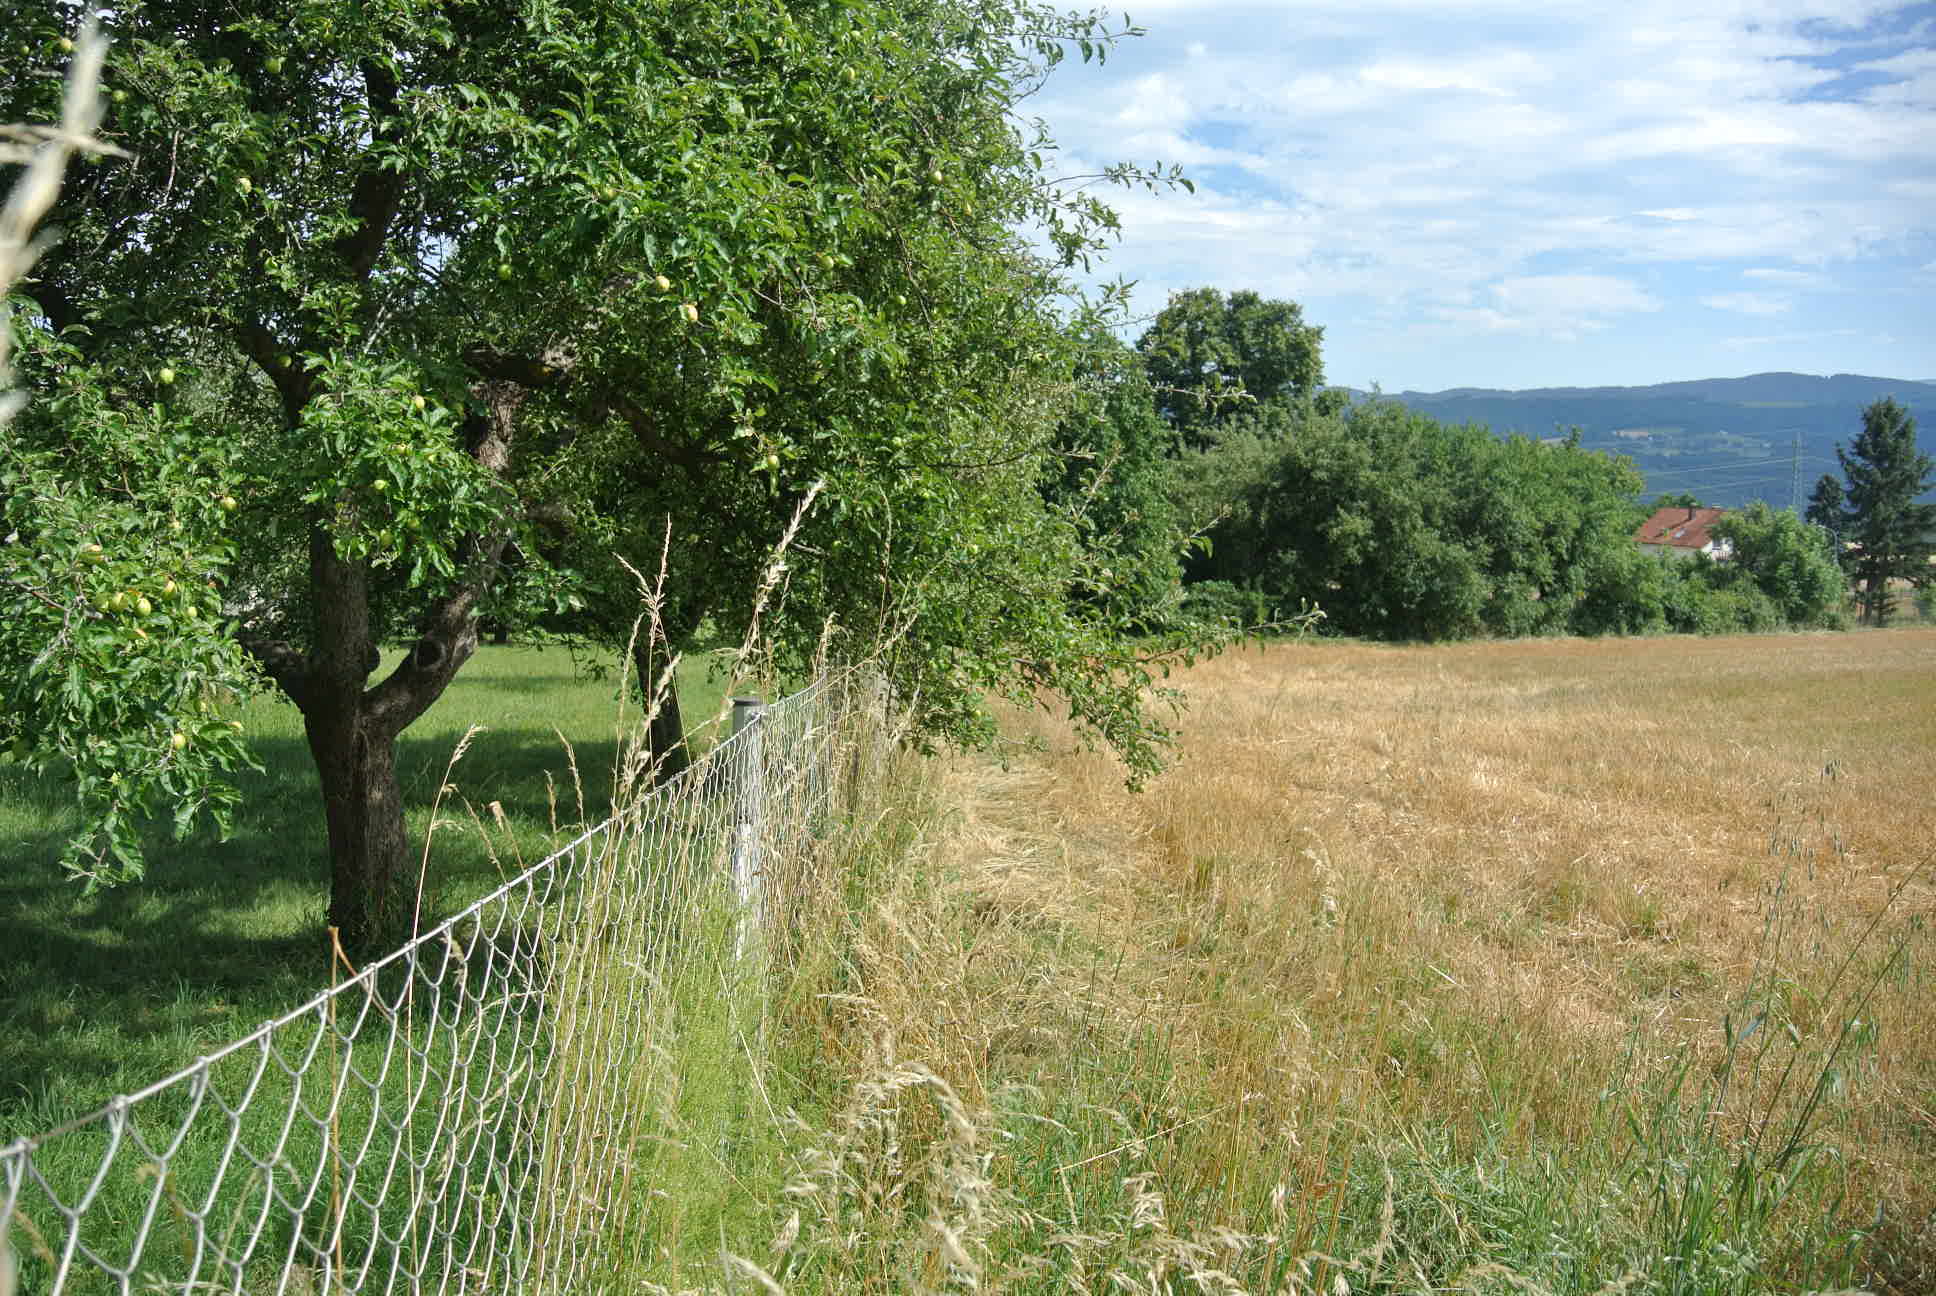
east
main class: Cropland
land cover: Apple fruit
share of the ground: > 75 %
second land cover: Grassland without tree/shrub cover
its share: > 75 %
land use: Kitchen garden
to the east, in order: Apple fruit; Grassland without tree/shrub cover; Fences; Grassland without tree/shrub cover; Electric lines; Fences; Managed hedges; Artificial constructions in urban areas; Grassland without tree/shrub cover; Paved roads, cycling and walking lanes; Grassland without tree/shrub cover
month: July
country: AT
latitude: 47.7000
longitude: 15.9859
